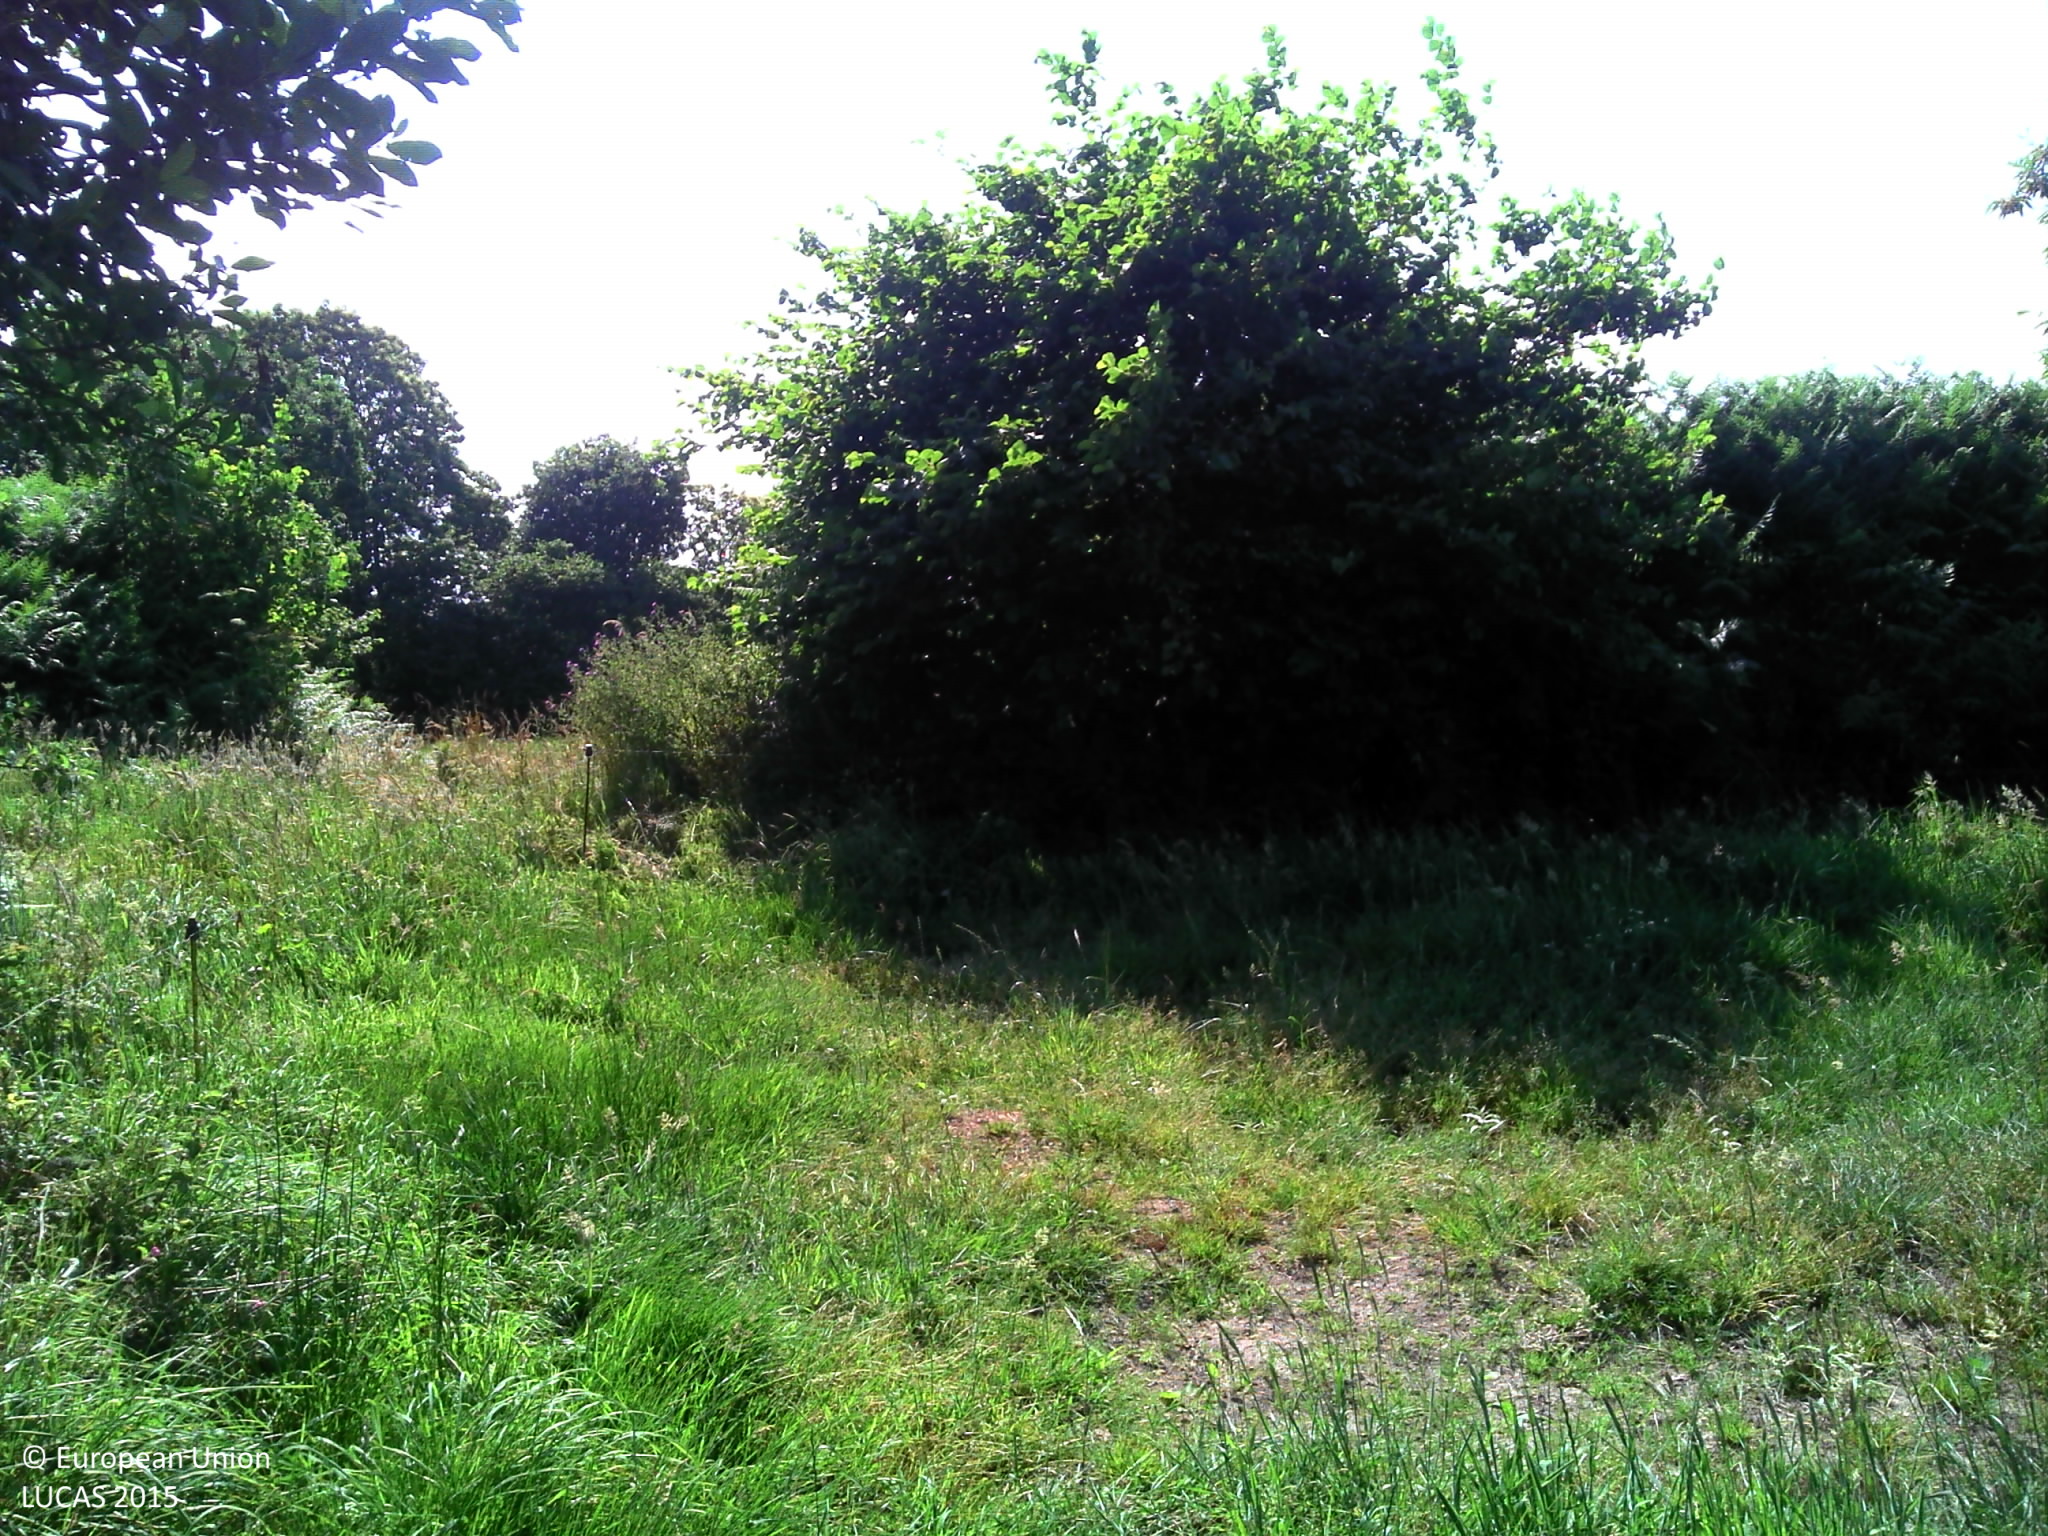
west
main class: Grassland
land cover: Grassland without tree/shrub cover
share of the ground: > 75 %
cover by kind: herbaceous plants 100 %
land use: Agriculture (excluding fallow land and kitchen gardens)
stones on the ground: < 10 %
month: July
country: FR
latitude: 48.7767
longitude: -3.4836
